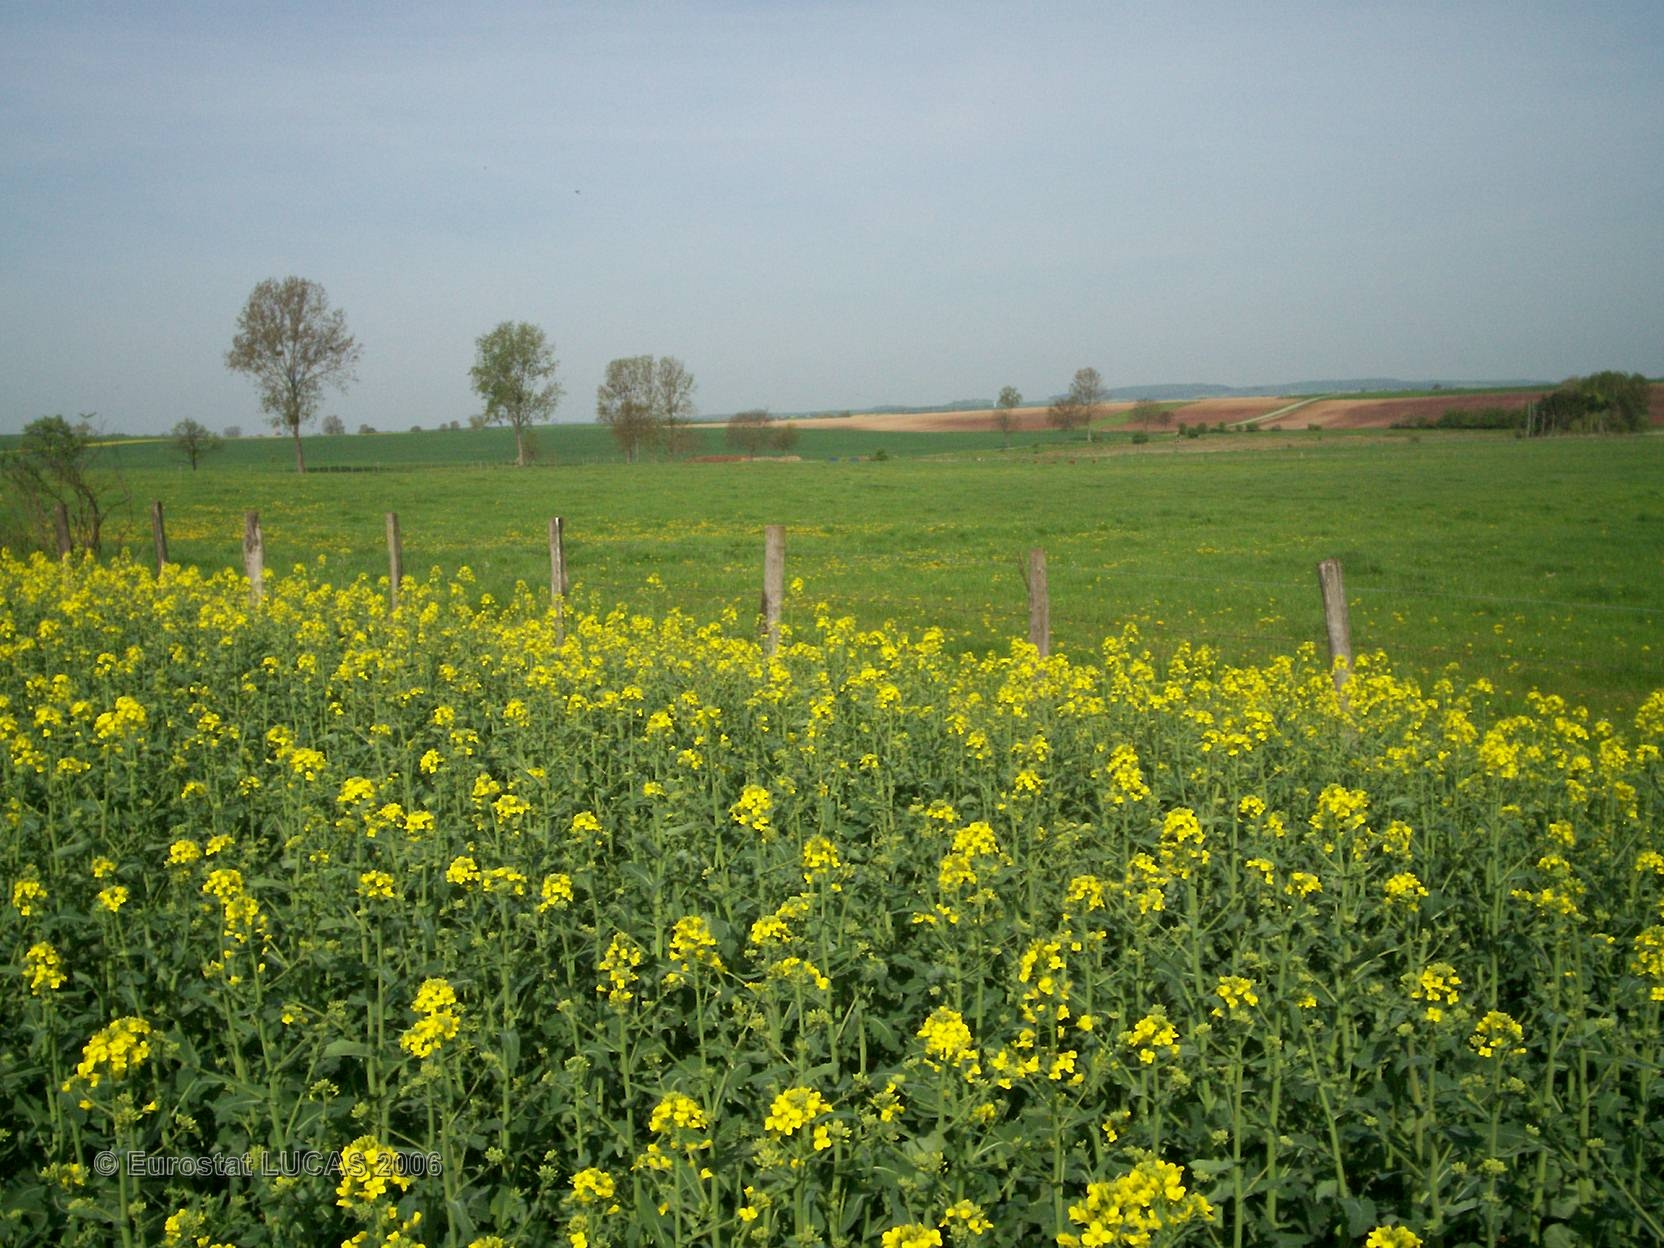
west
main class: Cropland
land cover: Rape and turnip rape
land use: Agriculture (excluding fallow land and kitchen gardens)
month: May
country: FR
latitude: 48.9550
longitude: 6.9277
